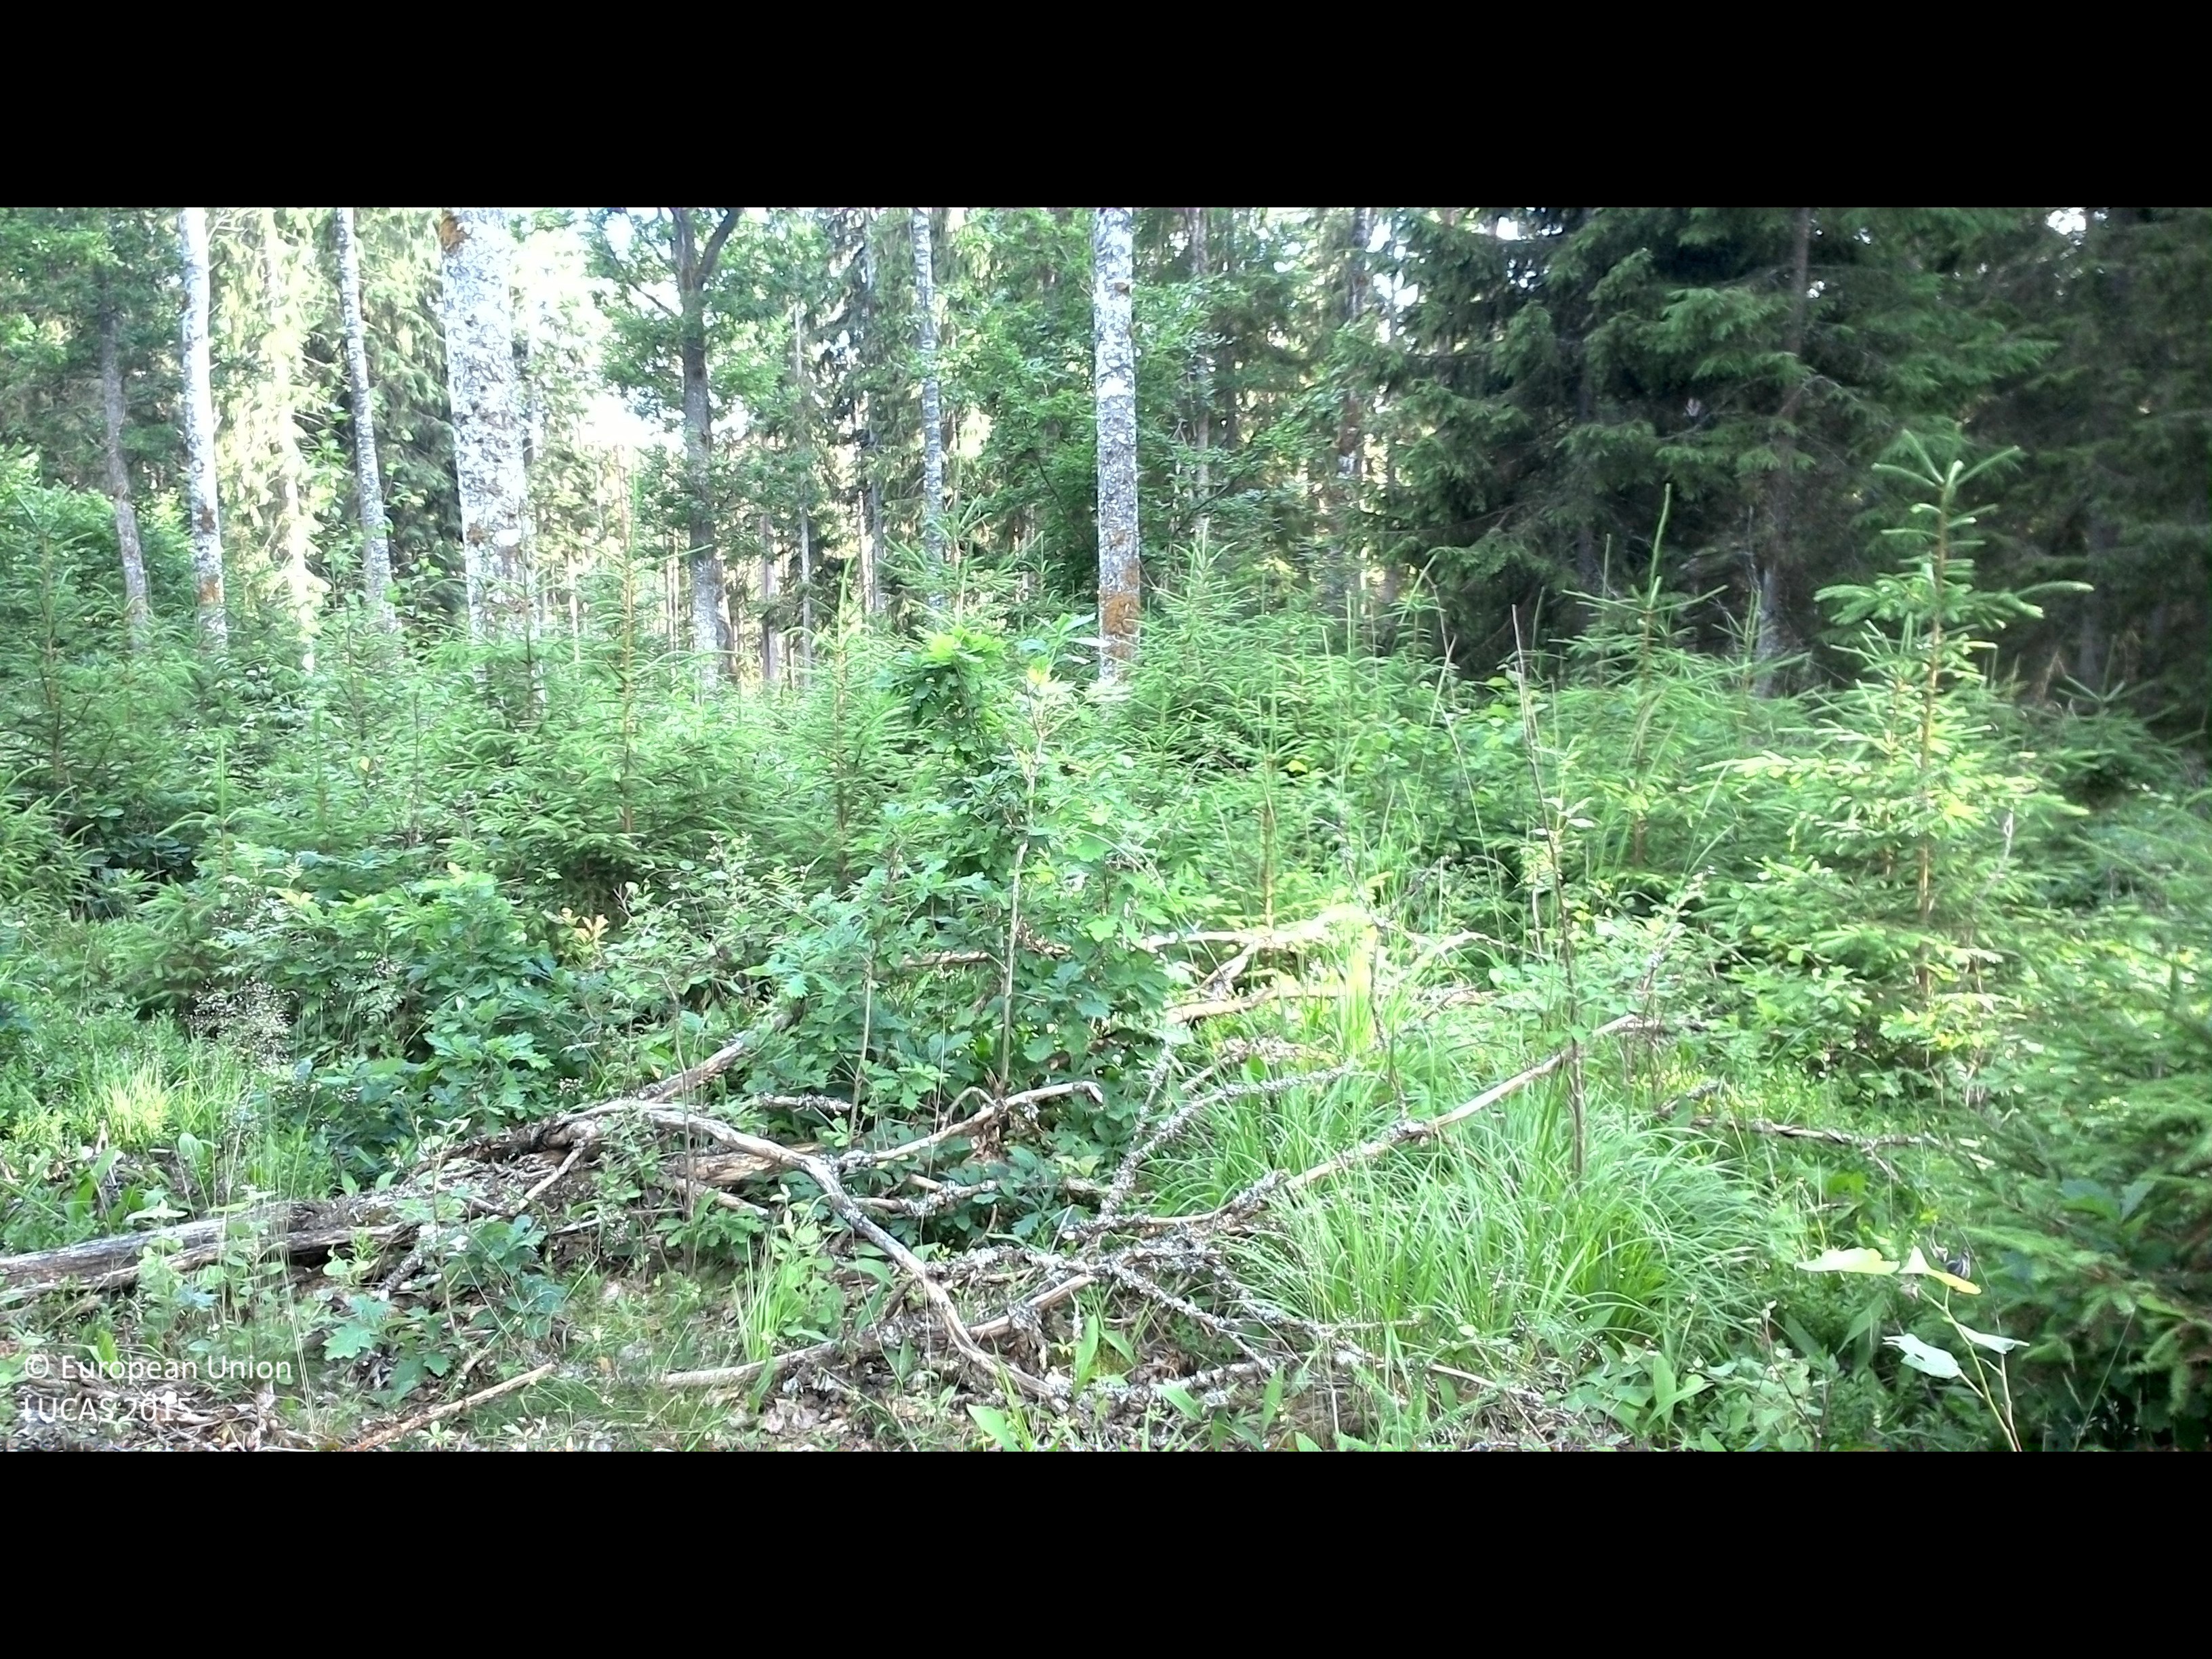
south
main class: Woodland
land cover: Broadleaved woodland
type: hemiboreal forest and nemoral coniferous forest and mixed broadleaved-coniferous forest
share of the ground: 50 - 75 %
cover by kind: broadleaved forest trees 65 %, shrubs 15 %, coniferous forest trees 10 %, herbaceous plants 10 %
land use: Forestry
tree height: > 5 m
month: July
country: SE
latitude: 56.4490
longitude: 15.0438
